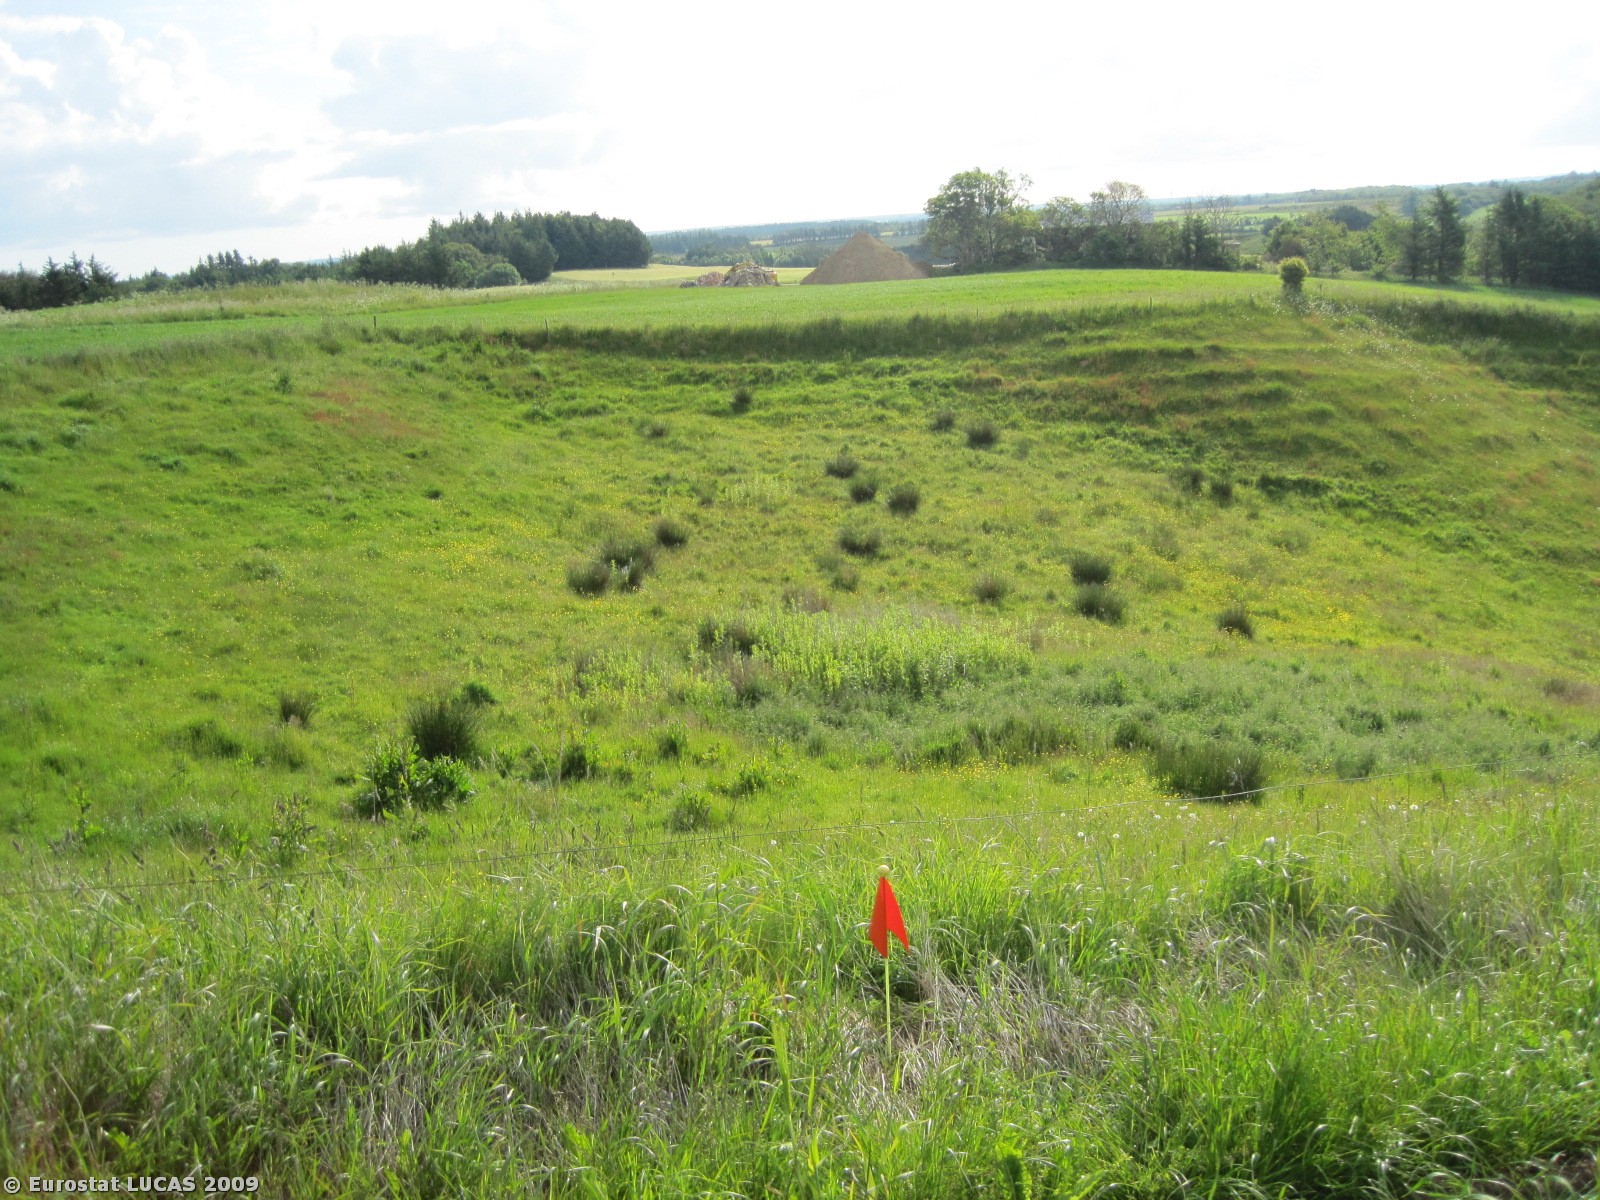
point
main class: Grassland
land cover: Grassland without tree/shrub cover
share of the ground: > 75 %
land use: Agriculture (excluding fallow land and kitchen gardens)
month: June
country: DK
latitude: 57.5361
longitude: 10.0500
